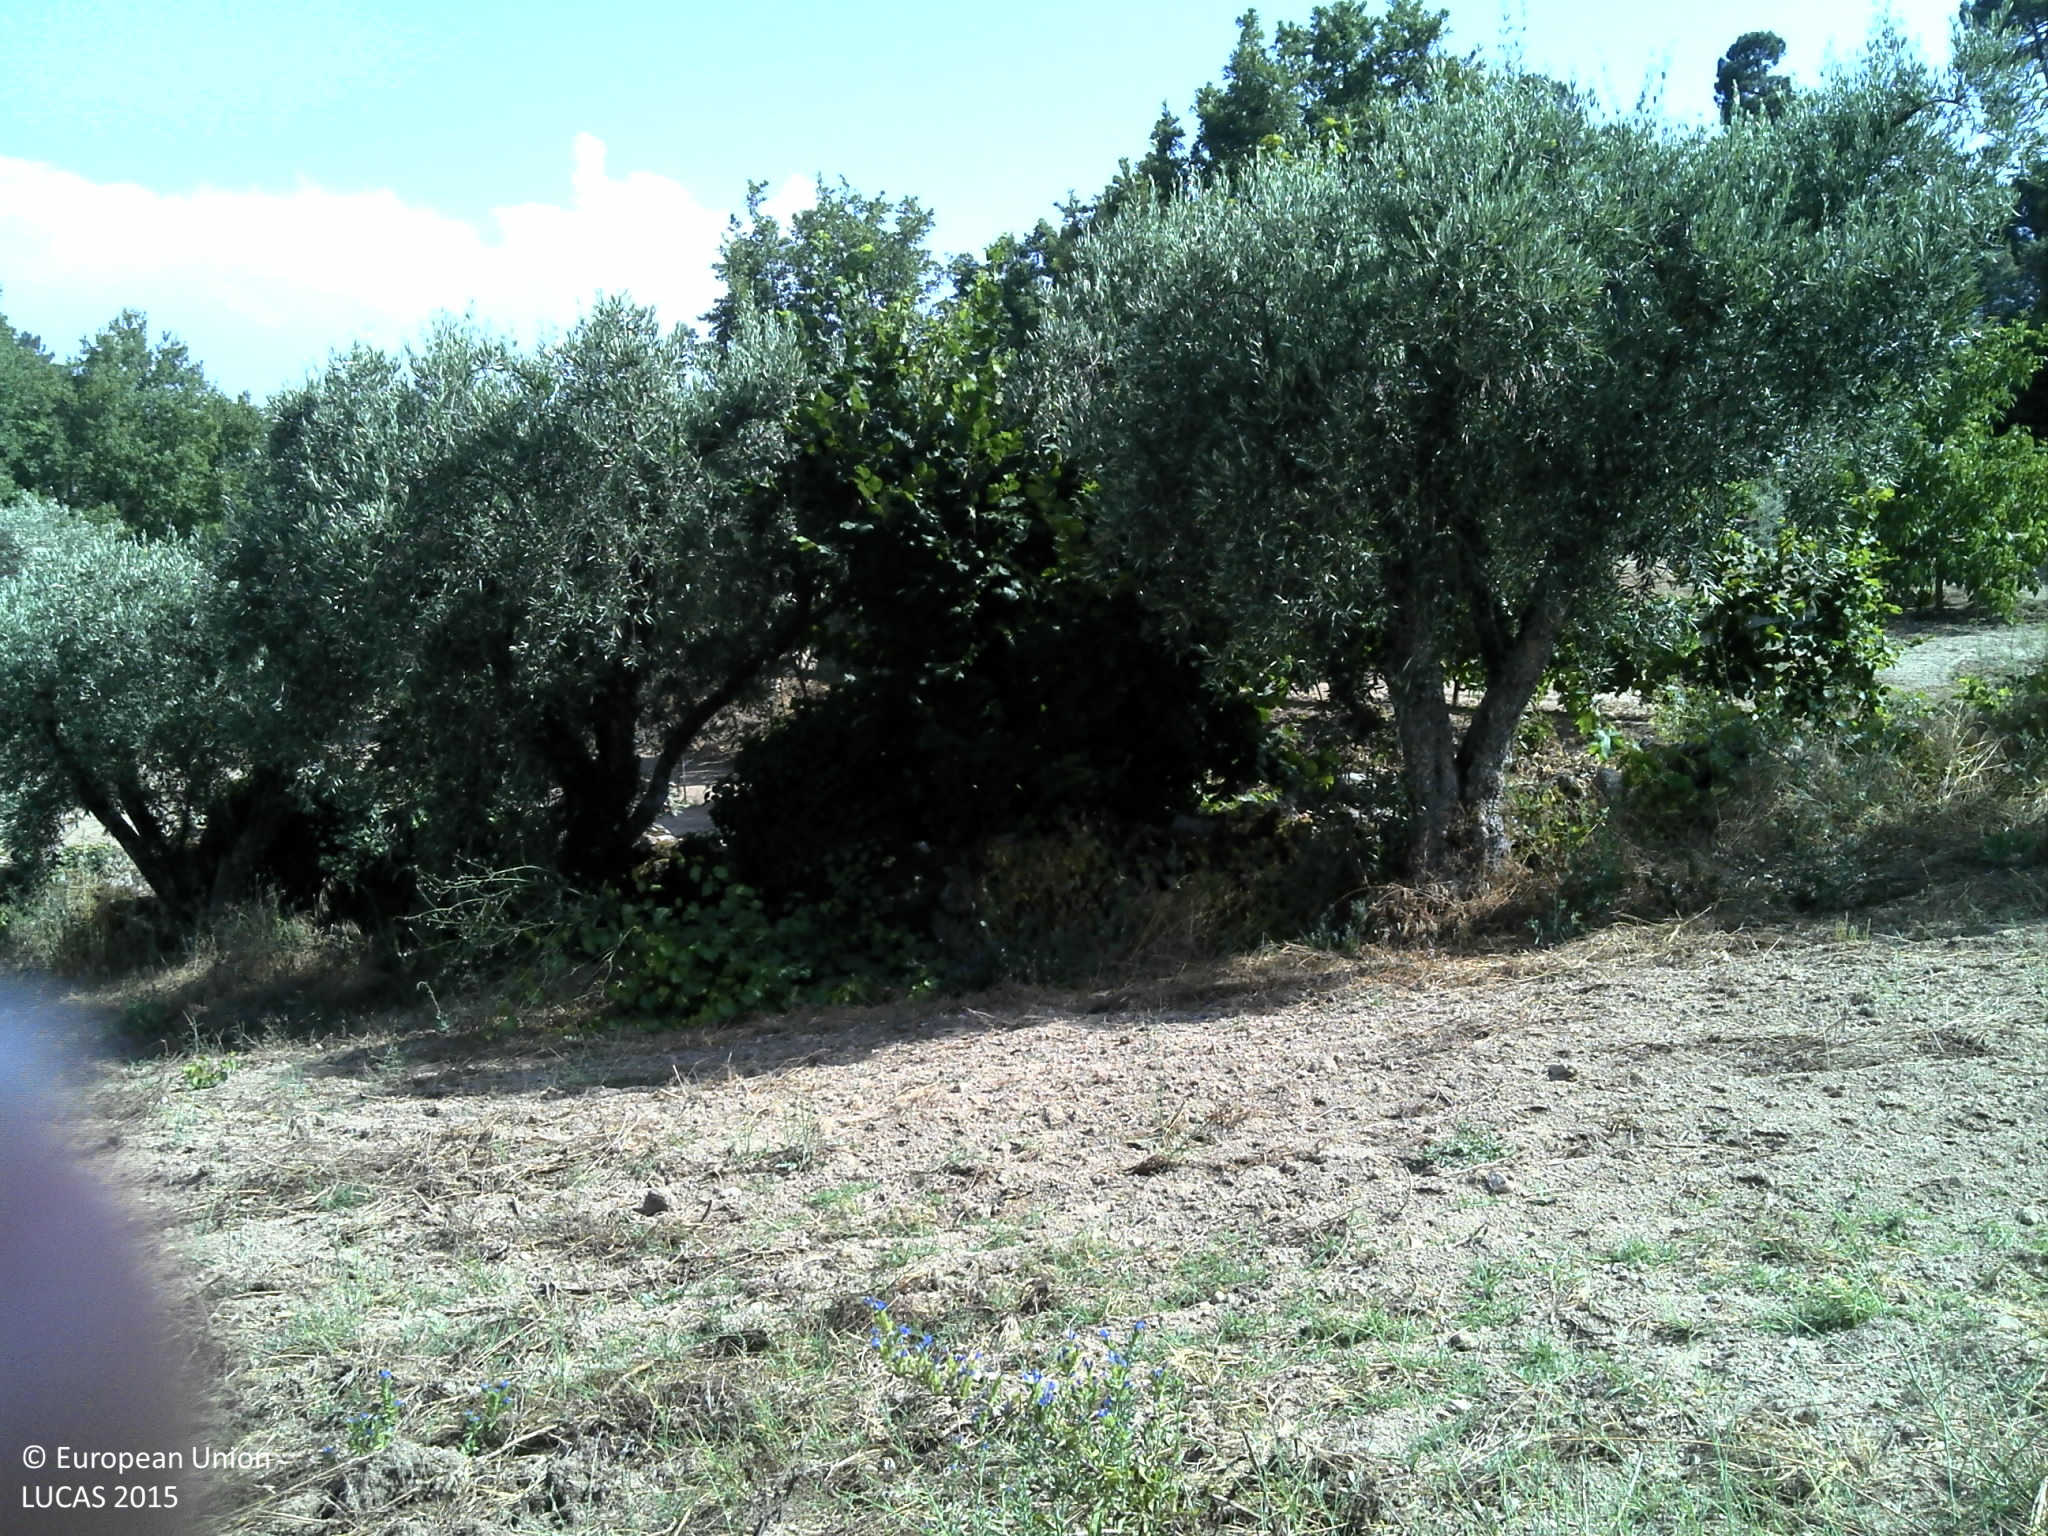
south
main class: Cropland
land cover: Olive groves
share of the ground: < 10 %
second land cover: Spontaneously vegetated surfaces
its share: 25 - 50 %
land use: Agriculture (excluding fallow land and kitchen gardens)
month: July
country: PT
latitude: 40.9249
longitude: -7.5397
